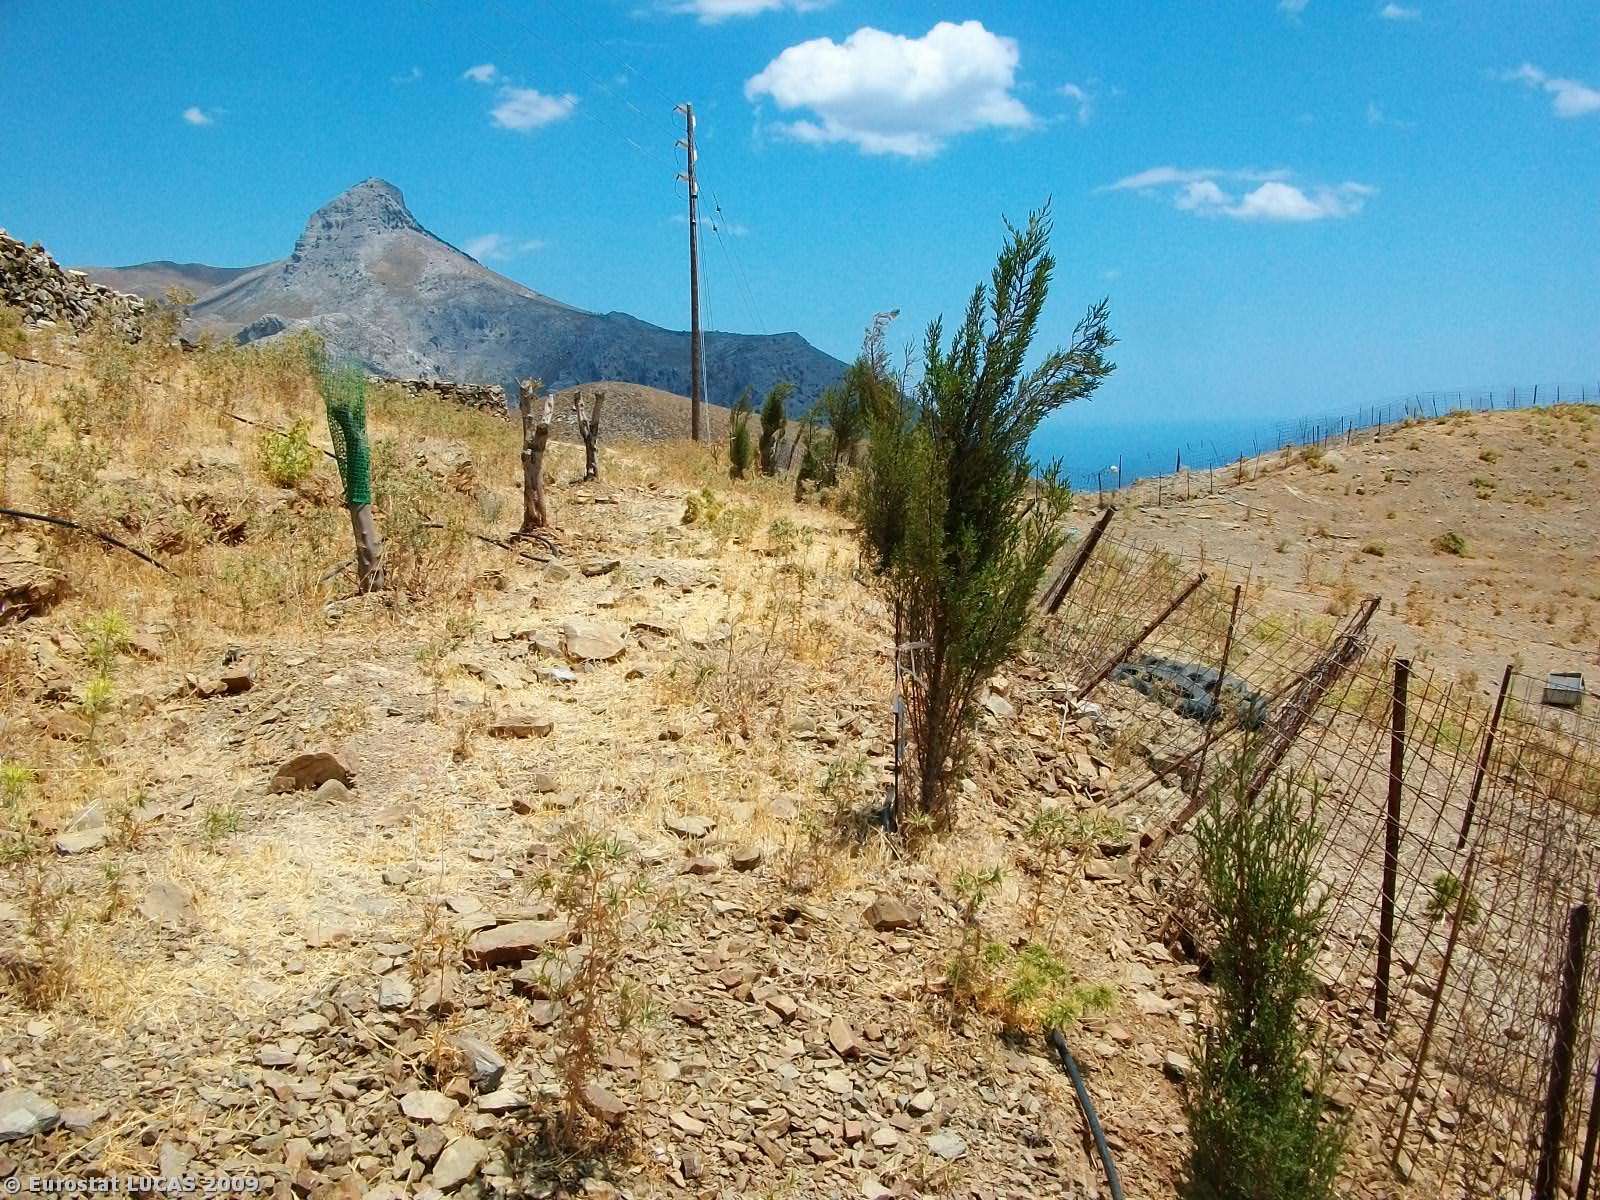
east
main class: Shrubland
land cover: Shrubland without tree cover
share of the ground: > 75 %
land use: Agriculture (excluding fallow land and kitchen gardens)
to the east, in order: Shrubland without tree cover
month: July
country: GR
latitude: 34.9587
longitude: 25.0425
